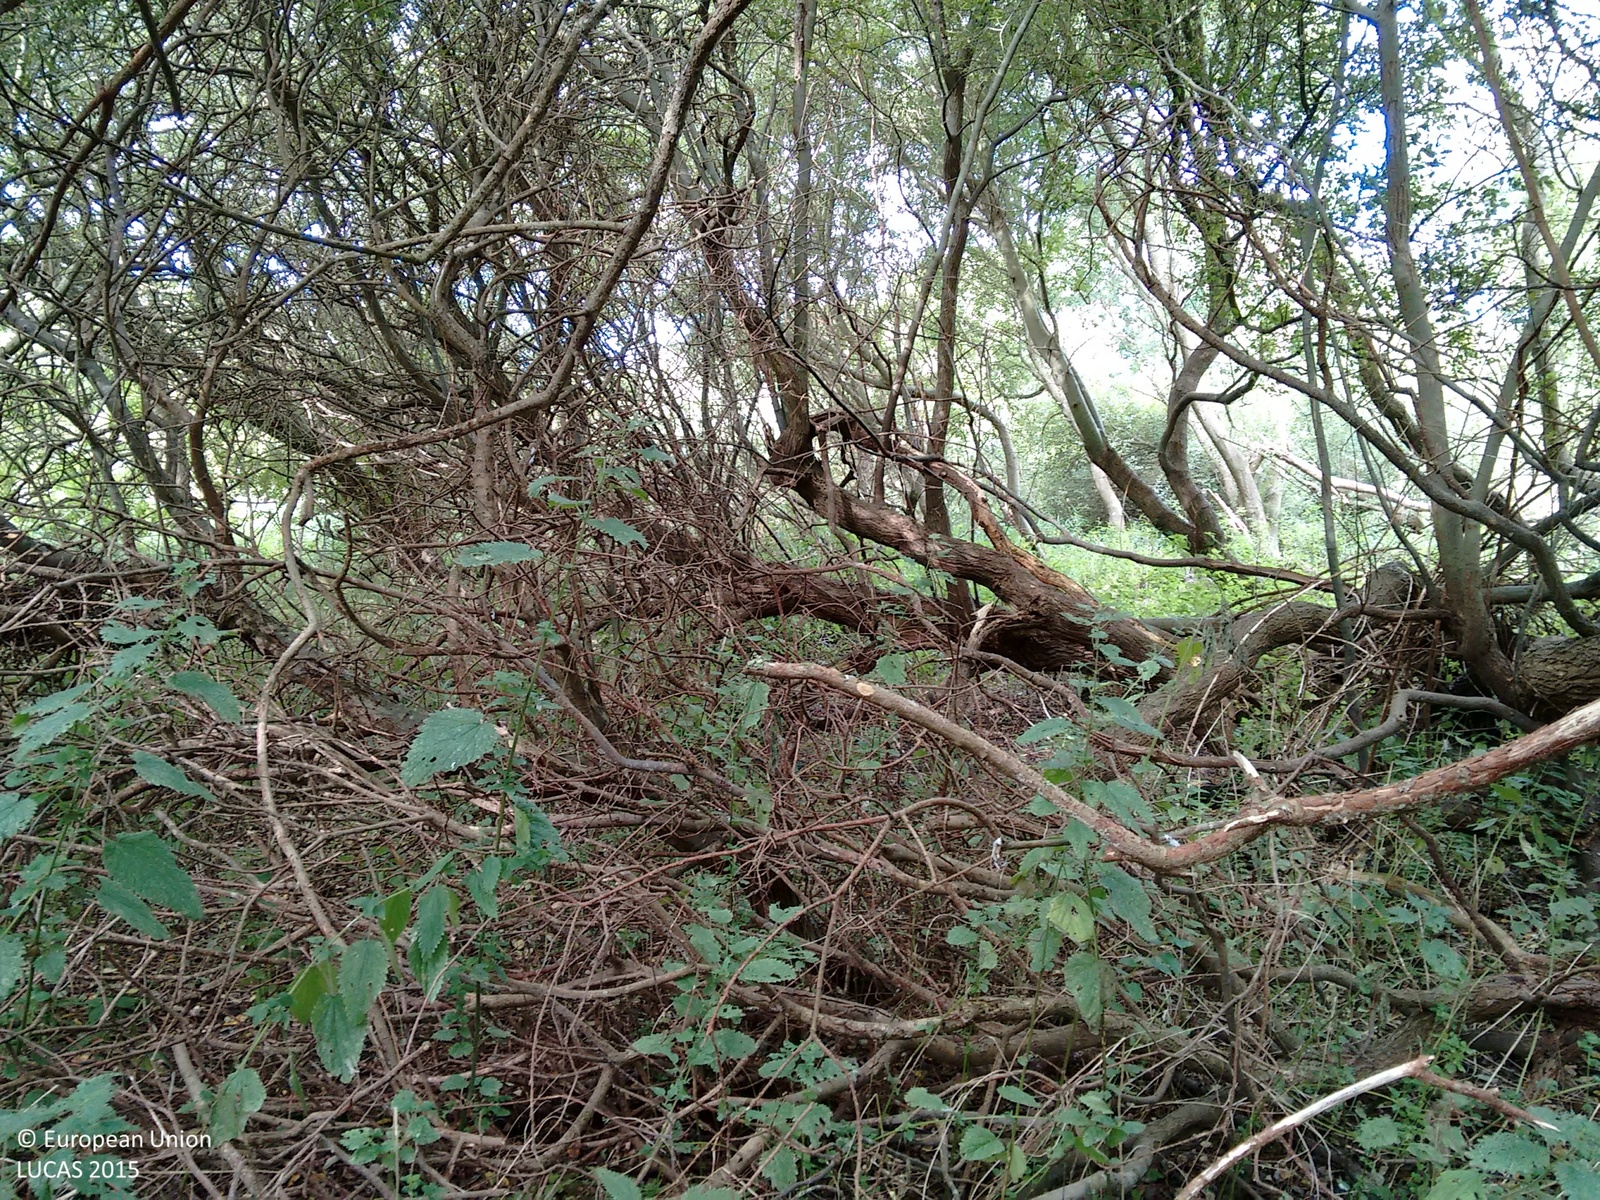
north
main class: Woodland
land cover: Other mixed woodland
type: mesophytic deciduous forest
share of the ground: > 75 %
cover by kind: broadleaved forest trees 75 %, coniferous forest trees 25 %
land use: Forestry
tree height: > 5 m
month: September
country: GB
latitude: 52.7353
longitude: 1.6739
